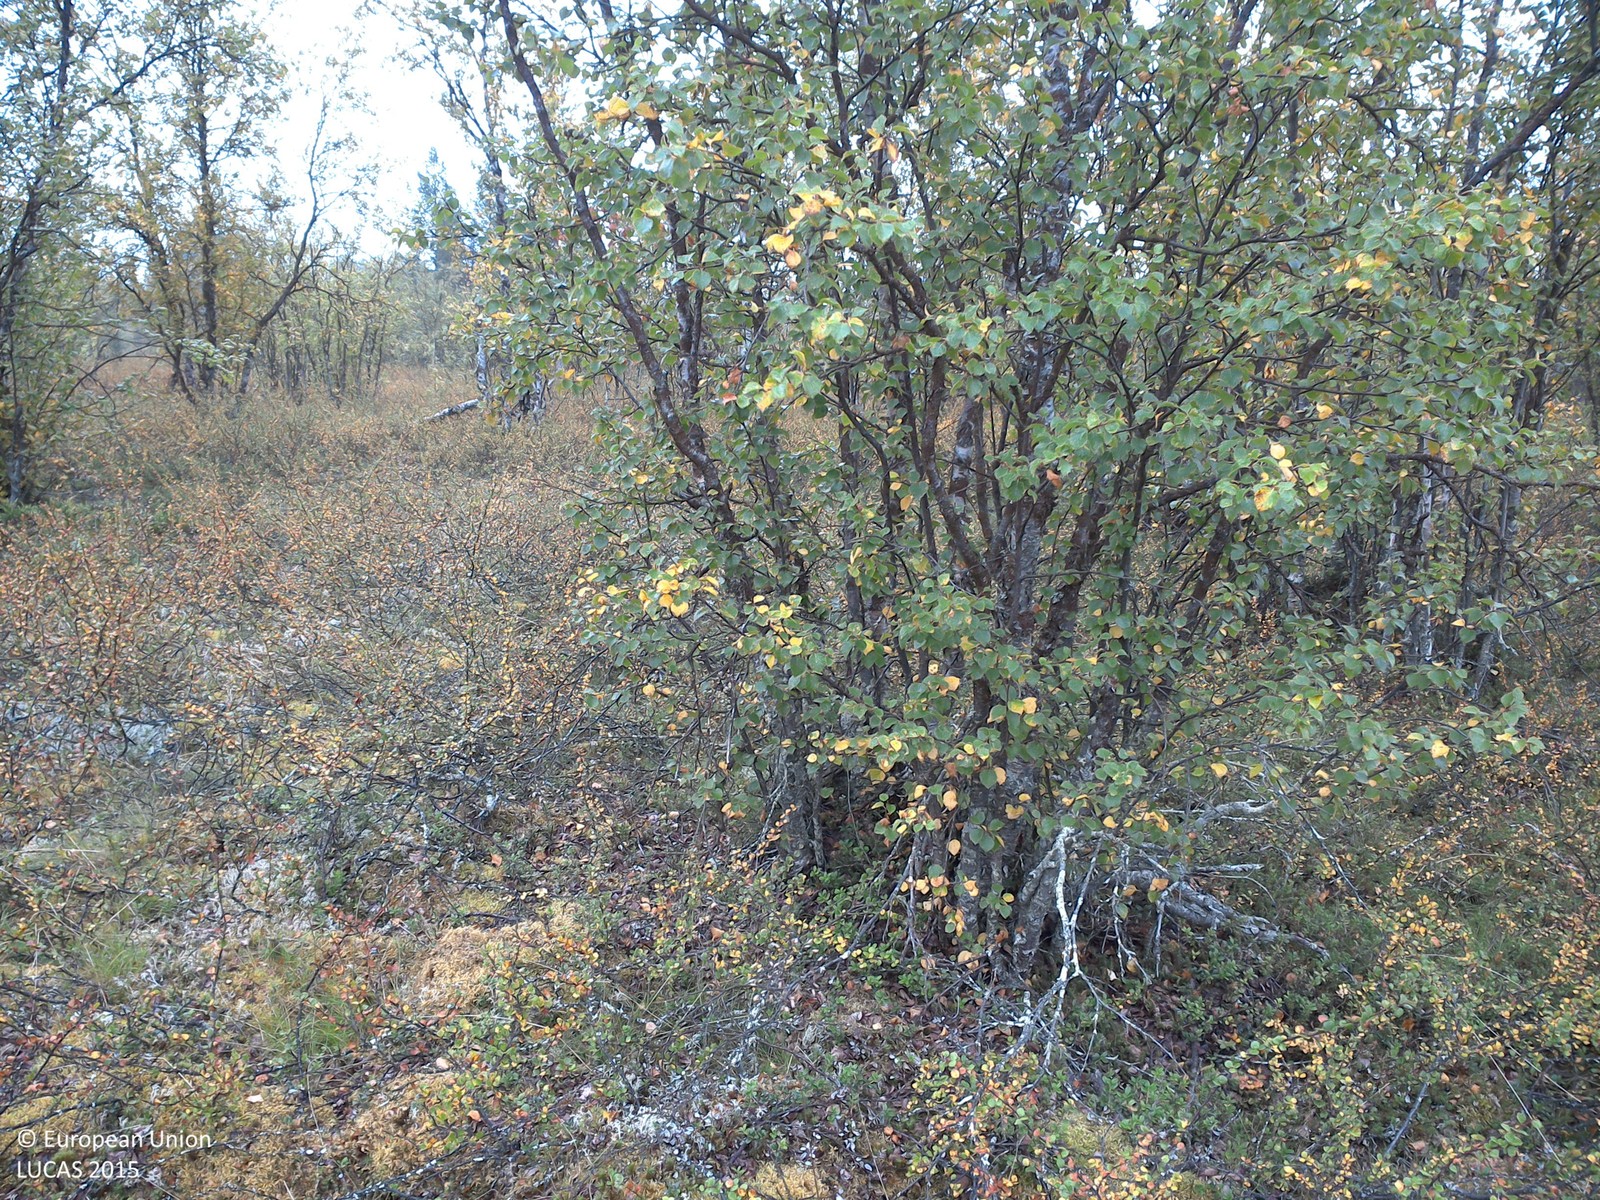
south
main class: Woodland
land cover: Broadleaved woodland
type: boreal forest
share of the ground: 10 - 25 %
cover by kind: shrubs 55 %, lichens and mosses 25 %, broadleaved forest trees 20 %
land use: Amenities, museums, leisure
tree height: > 5 m
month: August
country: SE
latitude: 68.1913
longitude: 21.8335
